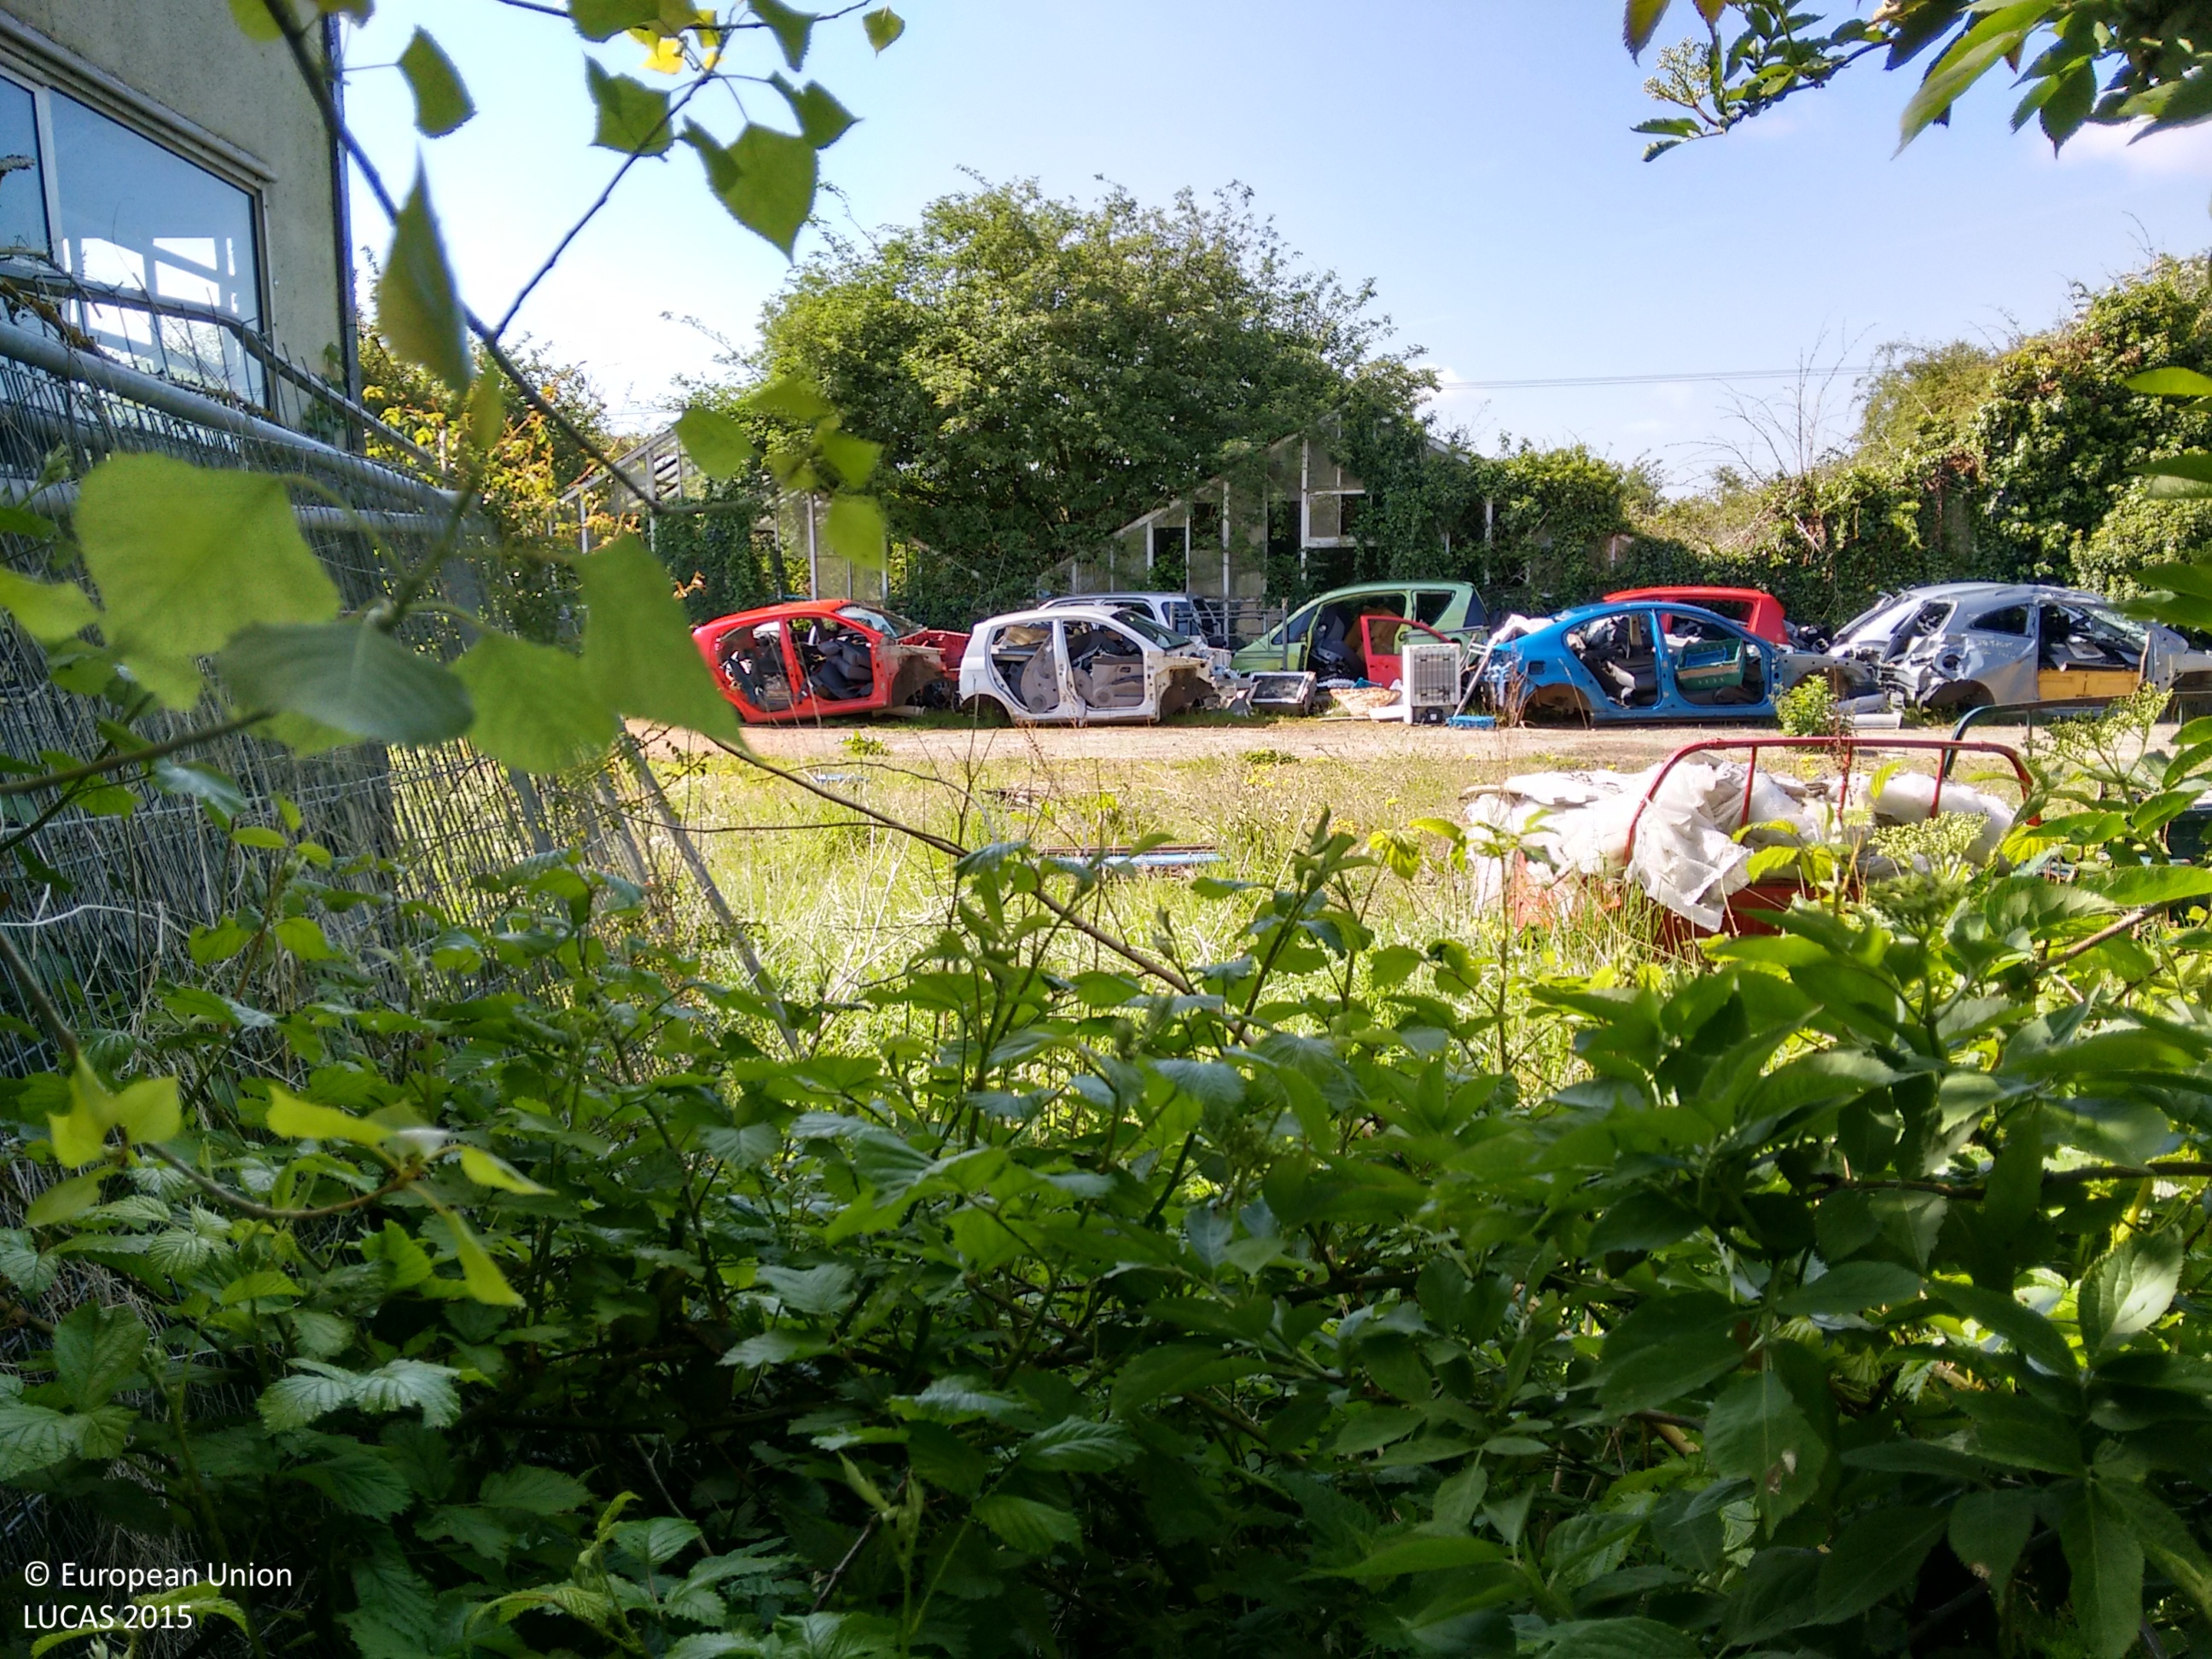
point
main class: Grassland
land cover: Grassland without tree/shrub cover
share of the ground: > 75 %
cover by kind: herbaceous plants 80 %, unconsolidated bare surface 20 %
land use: Logistics and storage
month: May
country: GB
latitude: 52.7843
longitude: -0.0408
